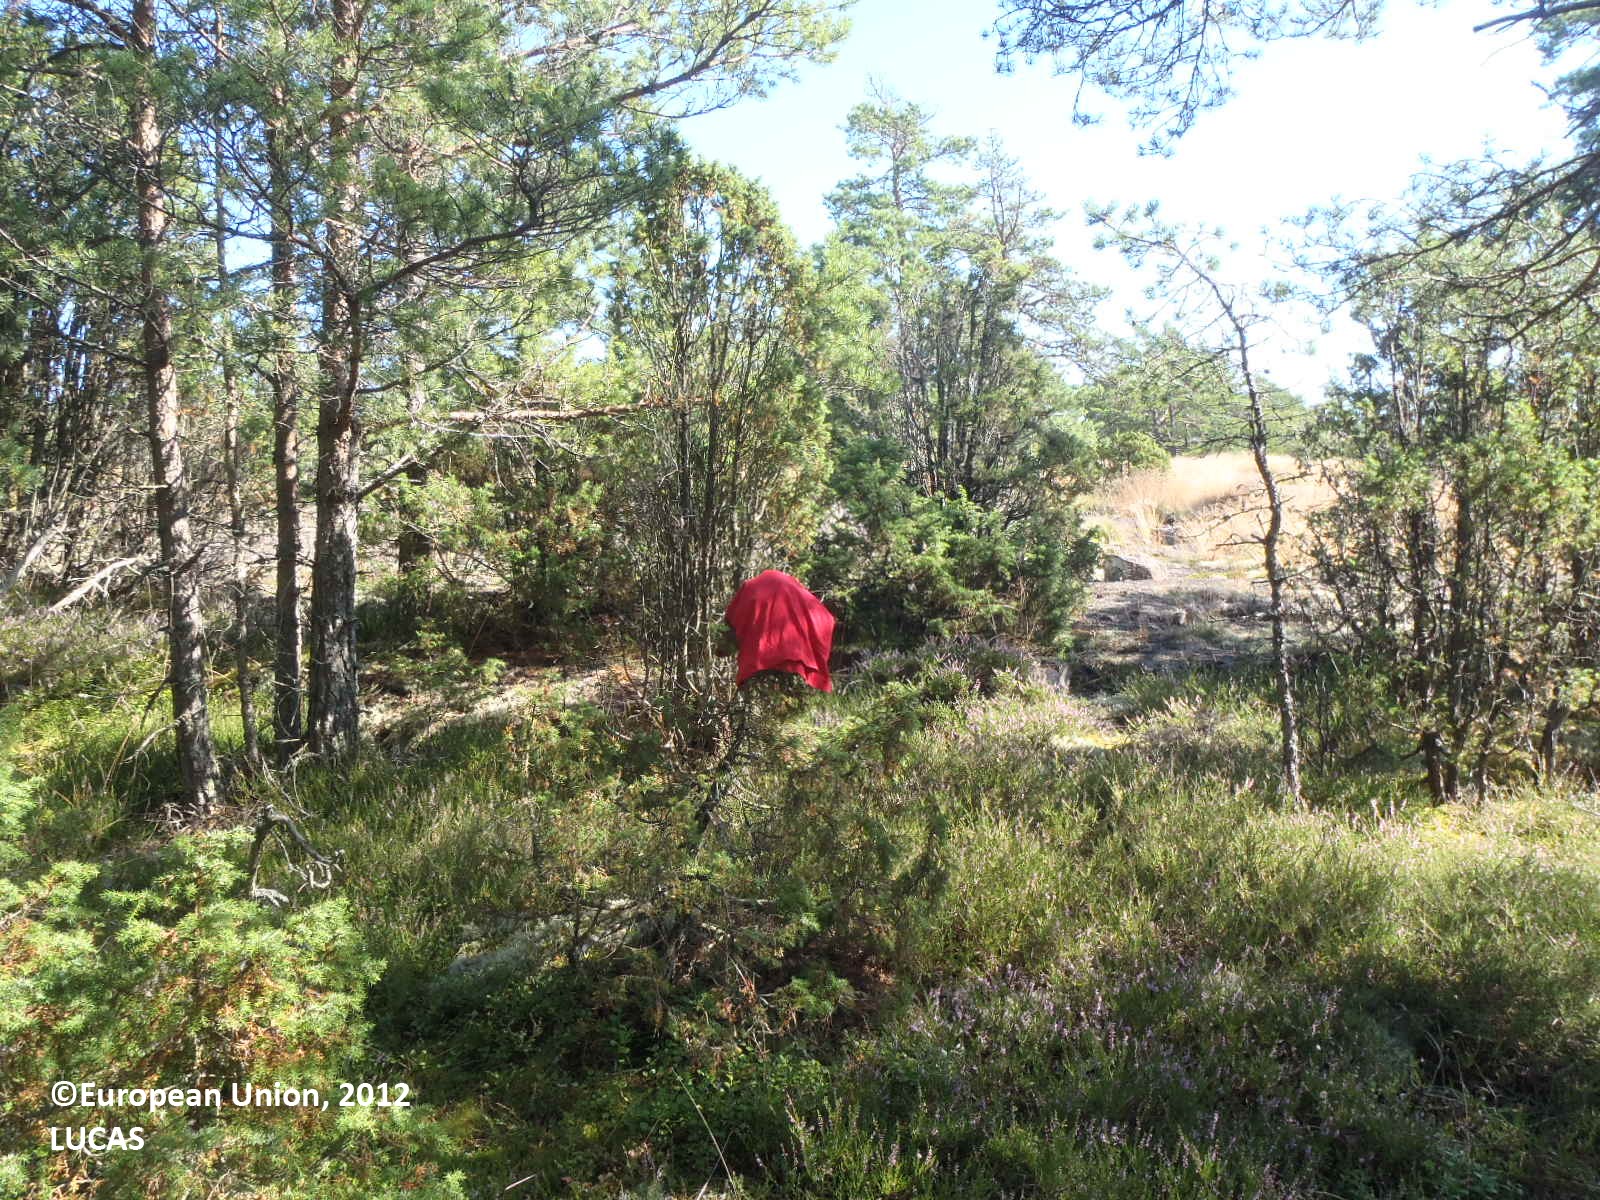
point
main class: Woodland
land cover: Pine dominated coniferous woodland
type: hemiboreal forest and nemoral coniferous forest and mixed broadleaved-coniferous forest
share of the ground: > 75 %
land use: Forestry
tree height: > 5 m
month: August
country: FI
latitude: 60.1741
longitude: 19.9382
